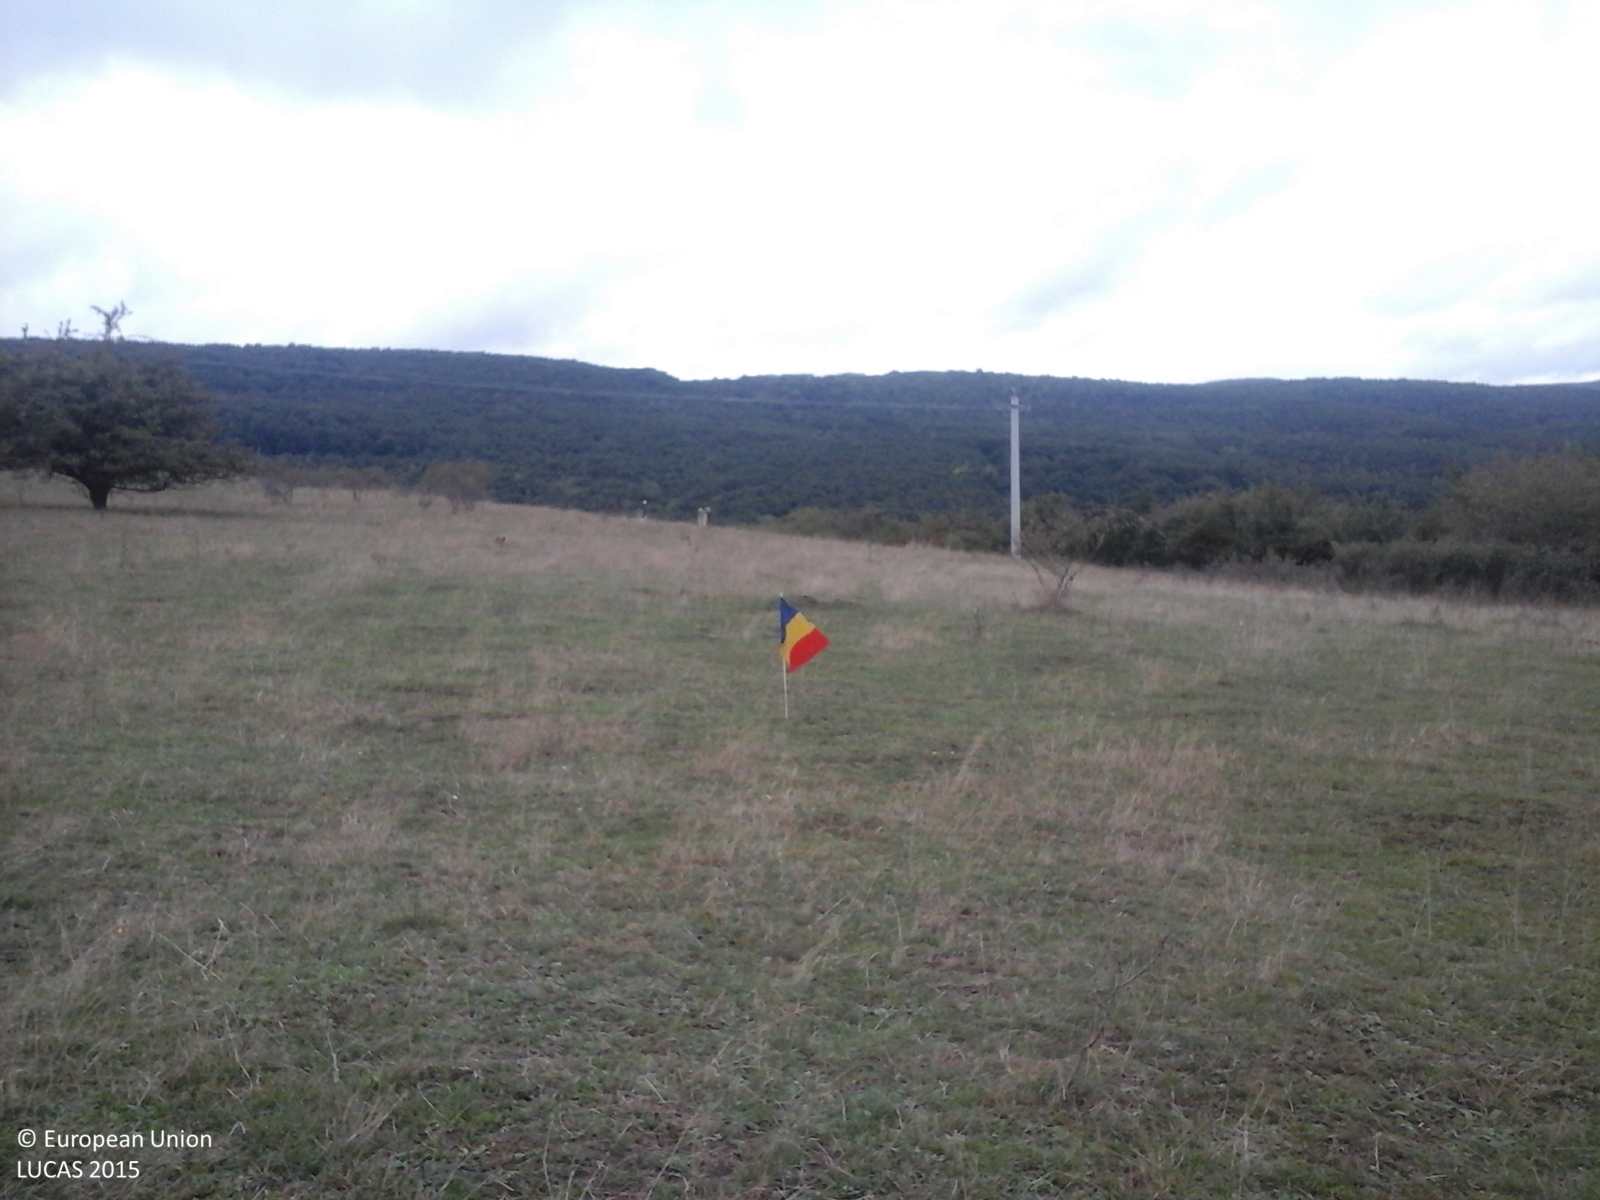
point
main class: Grassland
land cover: Grassland with sparse tree/shrub cover
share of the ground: > 75 %
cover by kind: herbaceous plants 85 %, shrubs 10 %, broadleaved forest trees 5 %
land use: Agriculture (excluding fallow land and kitchen gardens)
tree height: < 5 m
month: September
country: RO
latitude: 45.8443
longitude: 23.7293
